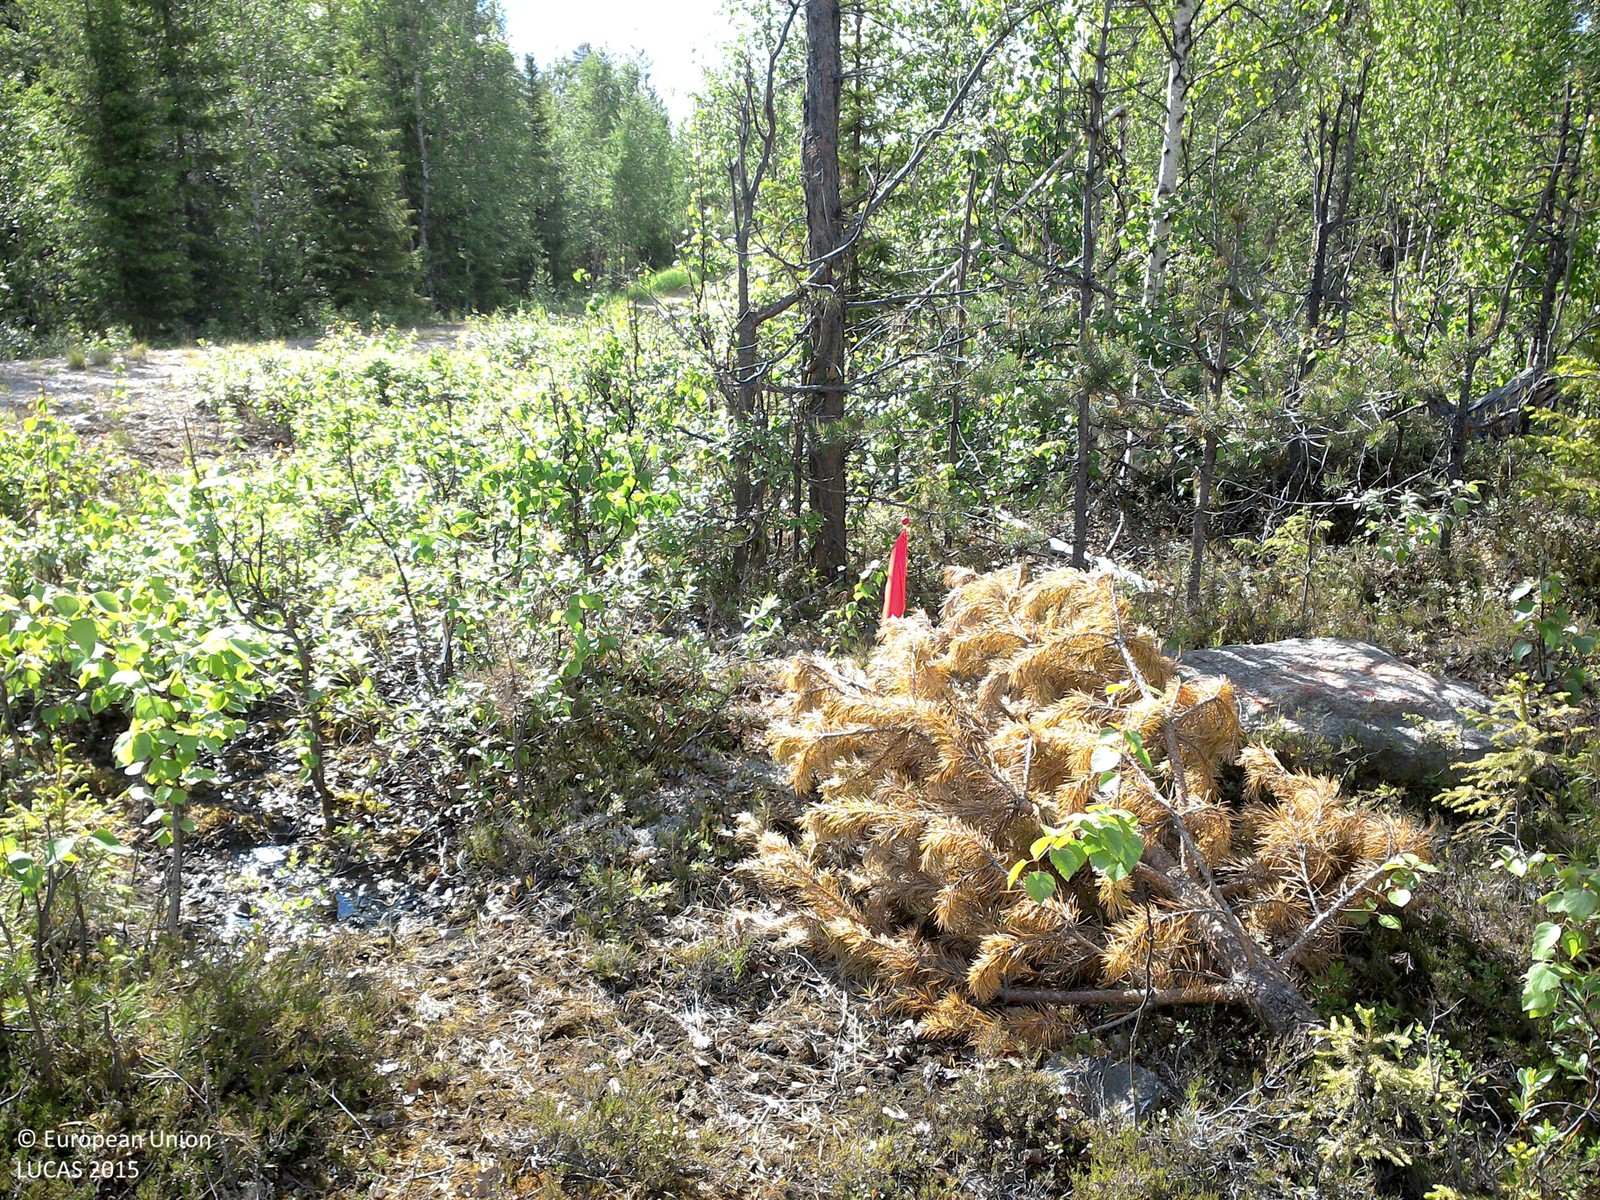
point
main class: Woodland
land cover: Pine dominated mixed woodland
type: boreal forest
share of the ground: 25 - 50 %
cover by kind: shrubs 65 %, coniferous forest trees 15 %, broadleaved forest trees 10 %, lichens and mosses 5 %, unconsolidated bare surface 5 %
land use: Forestry
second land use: Amenities, museums, leisure
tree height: > 5 m
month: June
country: SE
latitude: 66.6308
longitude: 22.8287
